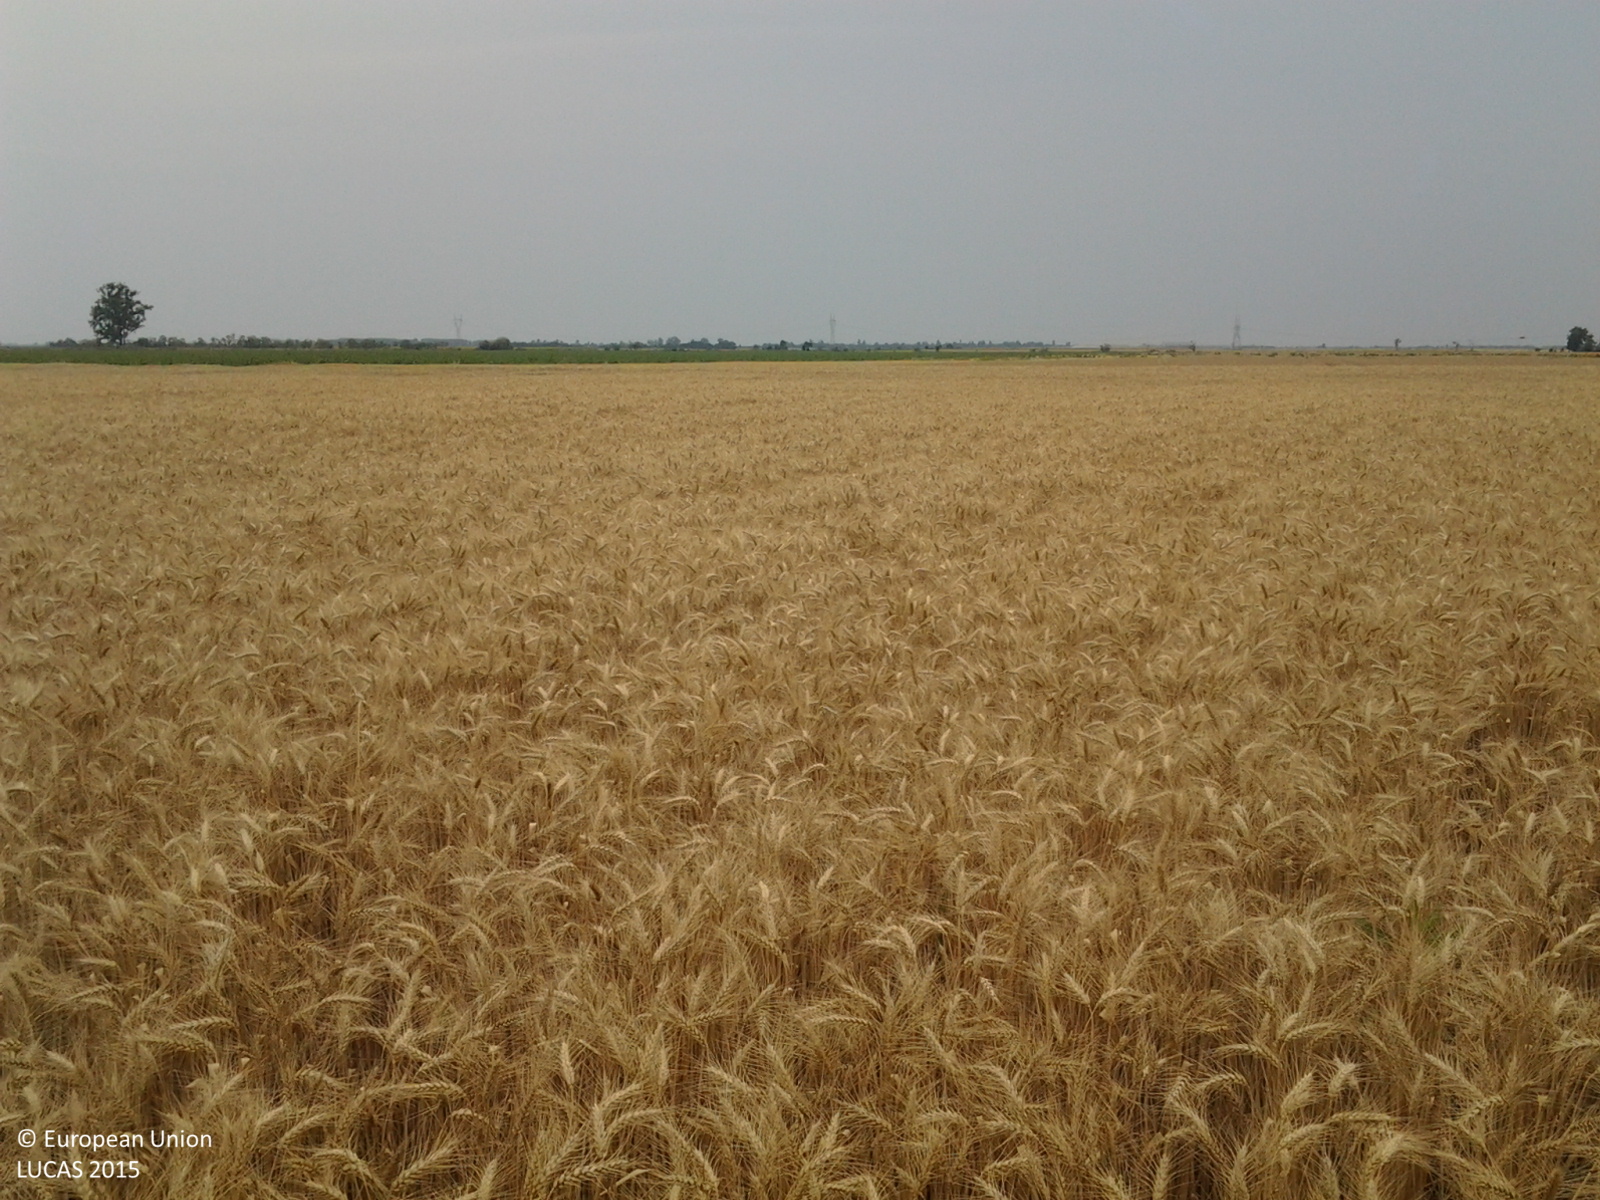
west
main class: Cropland
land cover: Common wheat
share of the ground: > 75 %
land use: Agriculture (excluding fallow land and kitchen gardens)
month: July
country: HU
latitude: 47.4029
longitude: 20.2176
